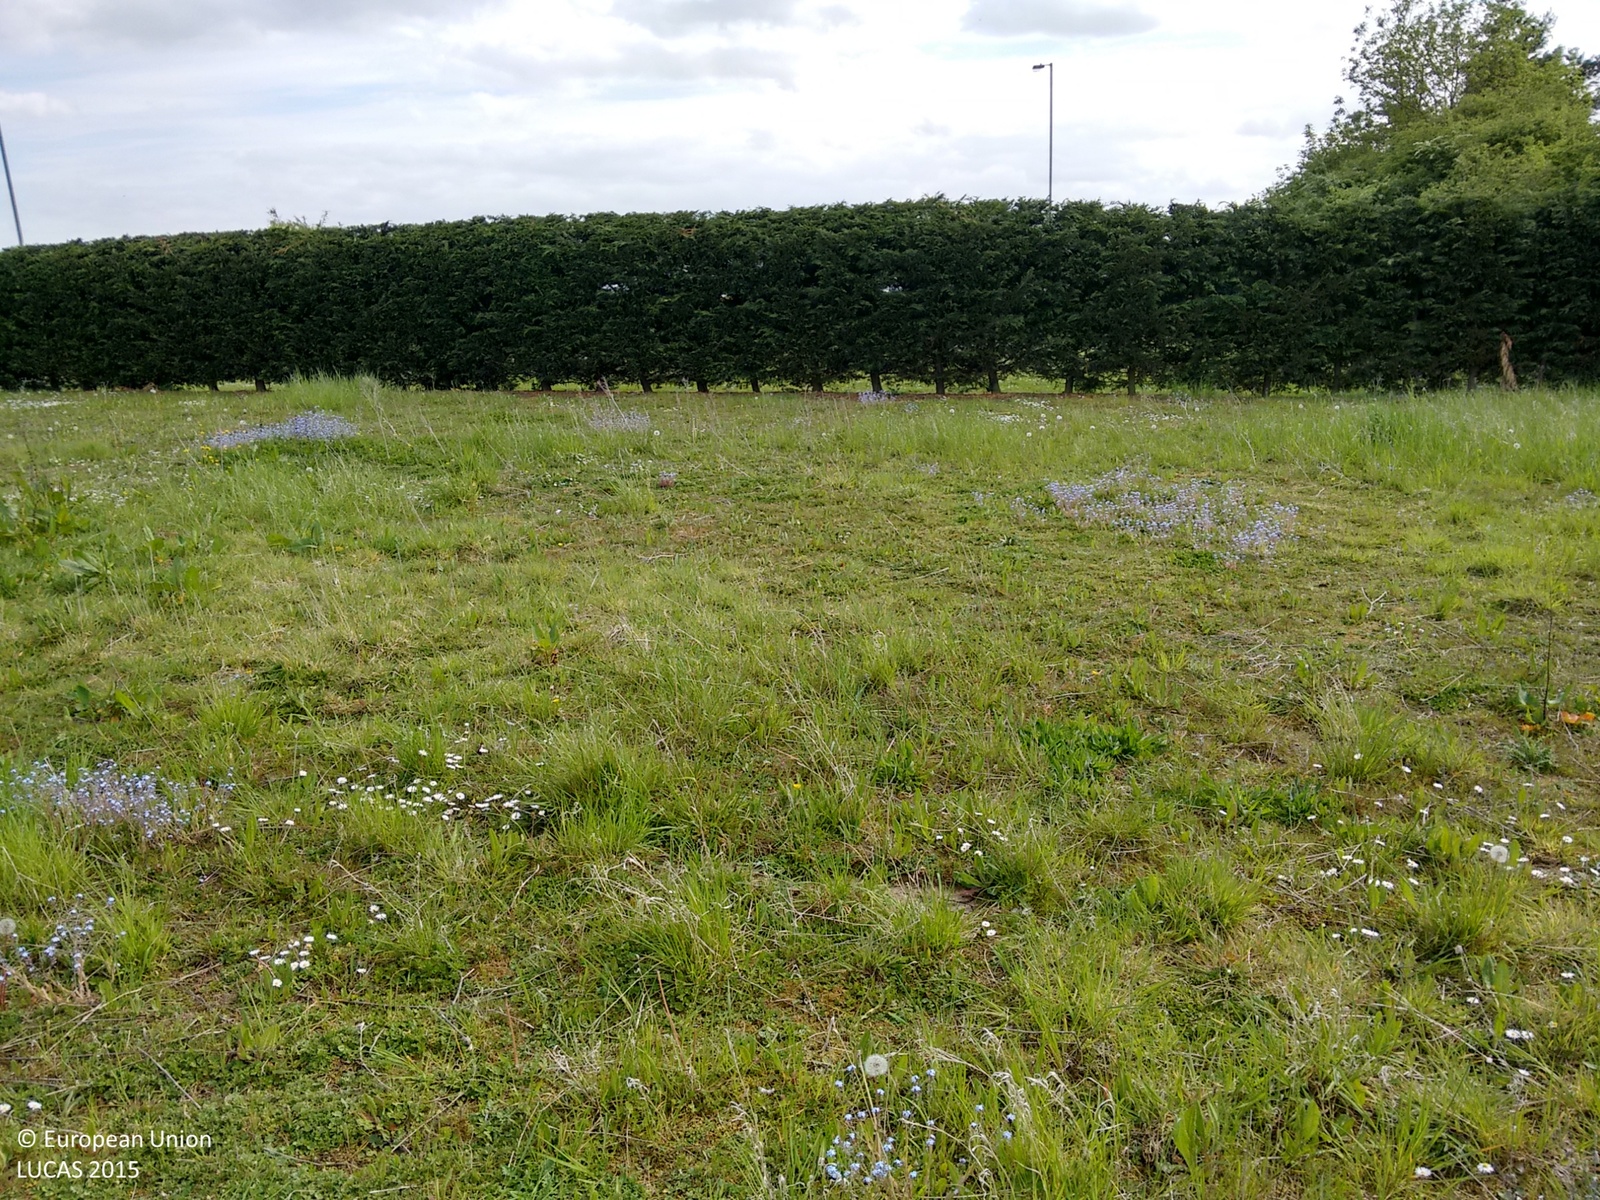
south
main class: Grassland
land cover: Grassland without tree/shrub cover
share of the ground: > 75 %
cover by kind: herbaceous plants 100 %
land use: Agriculture (excluding fallow land and kitchen gardens)
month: May
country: GB
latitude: 52.9570
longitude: -0.1412
